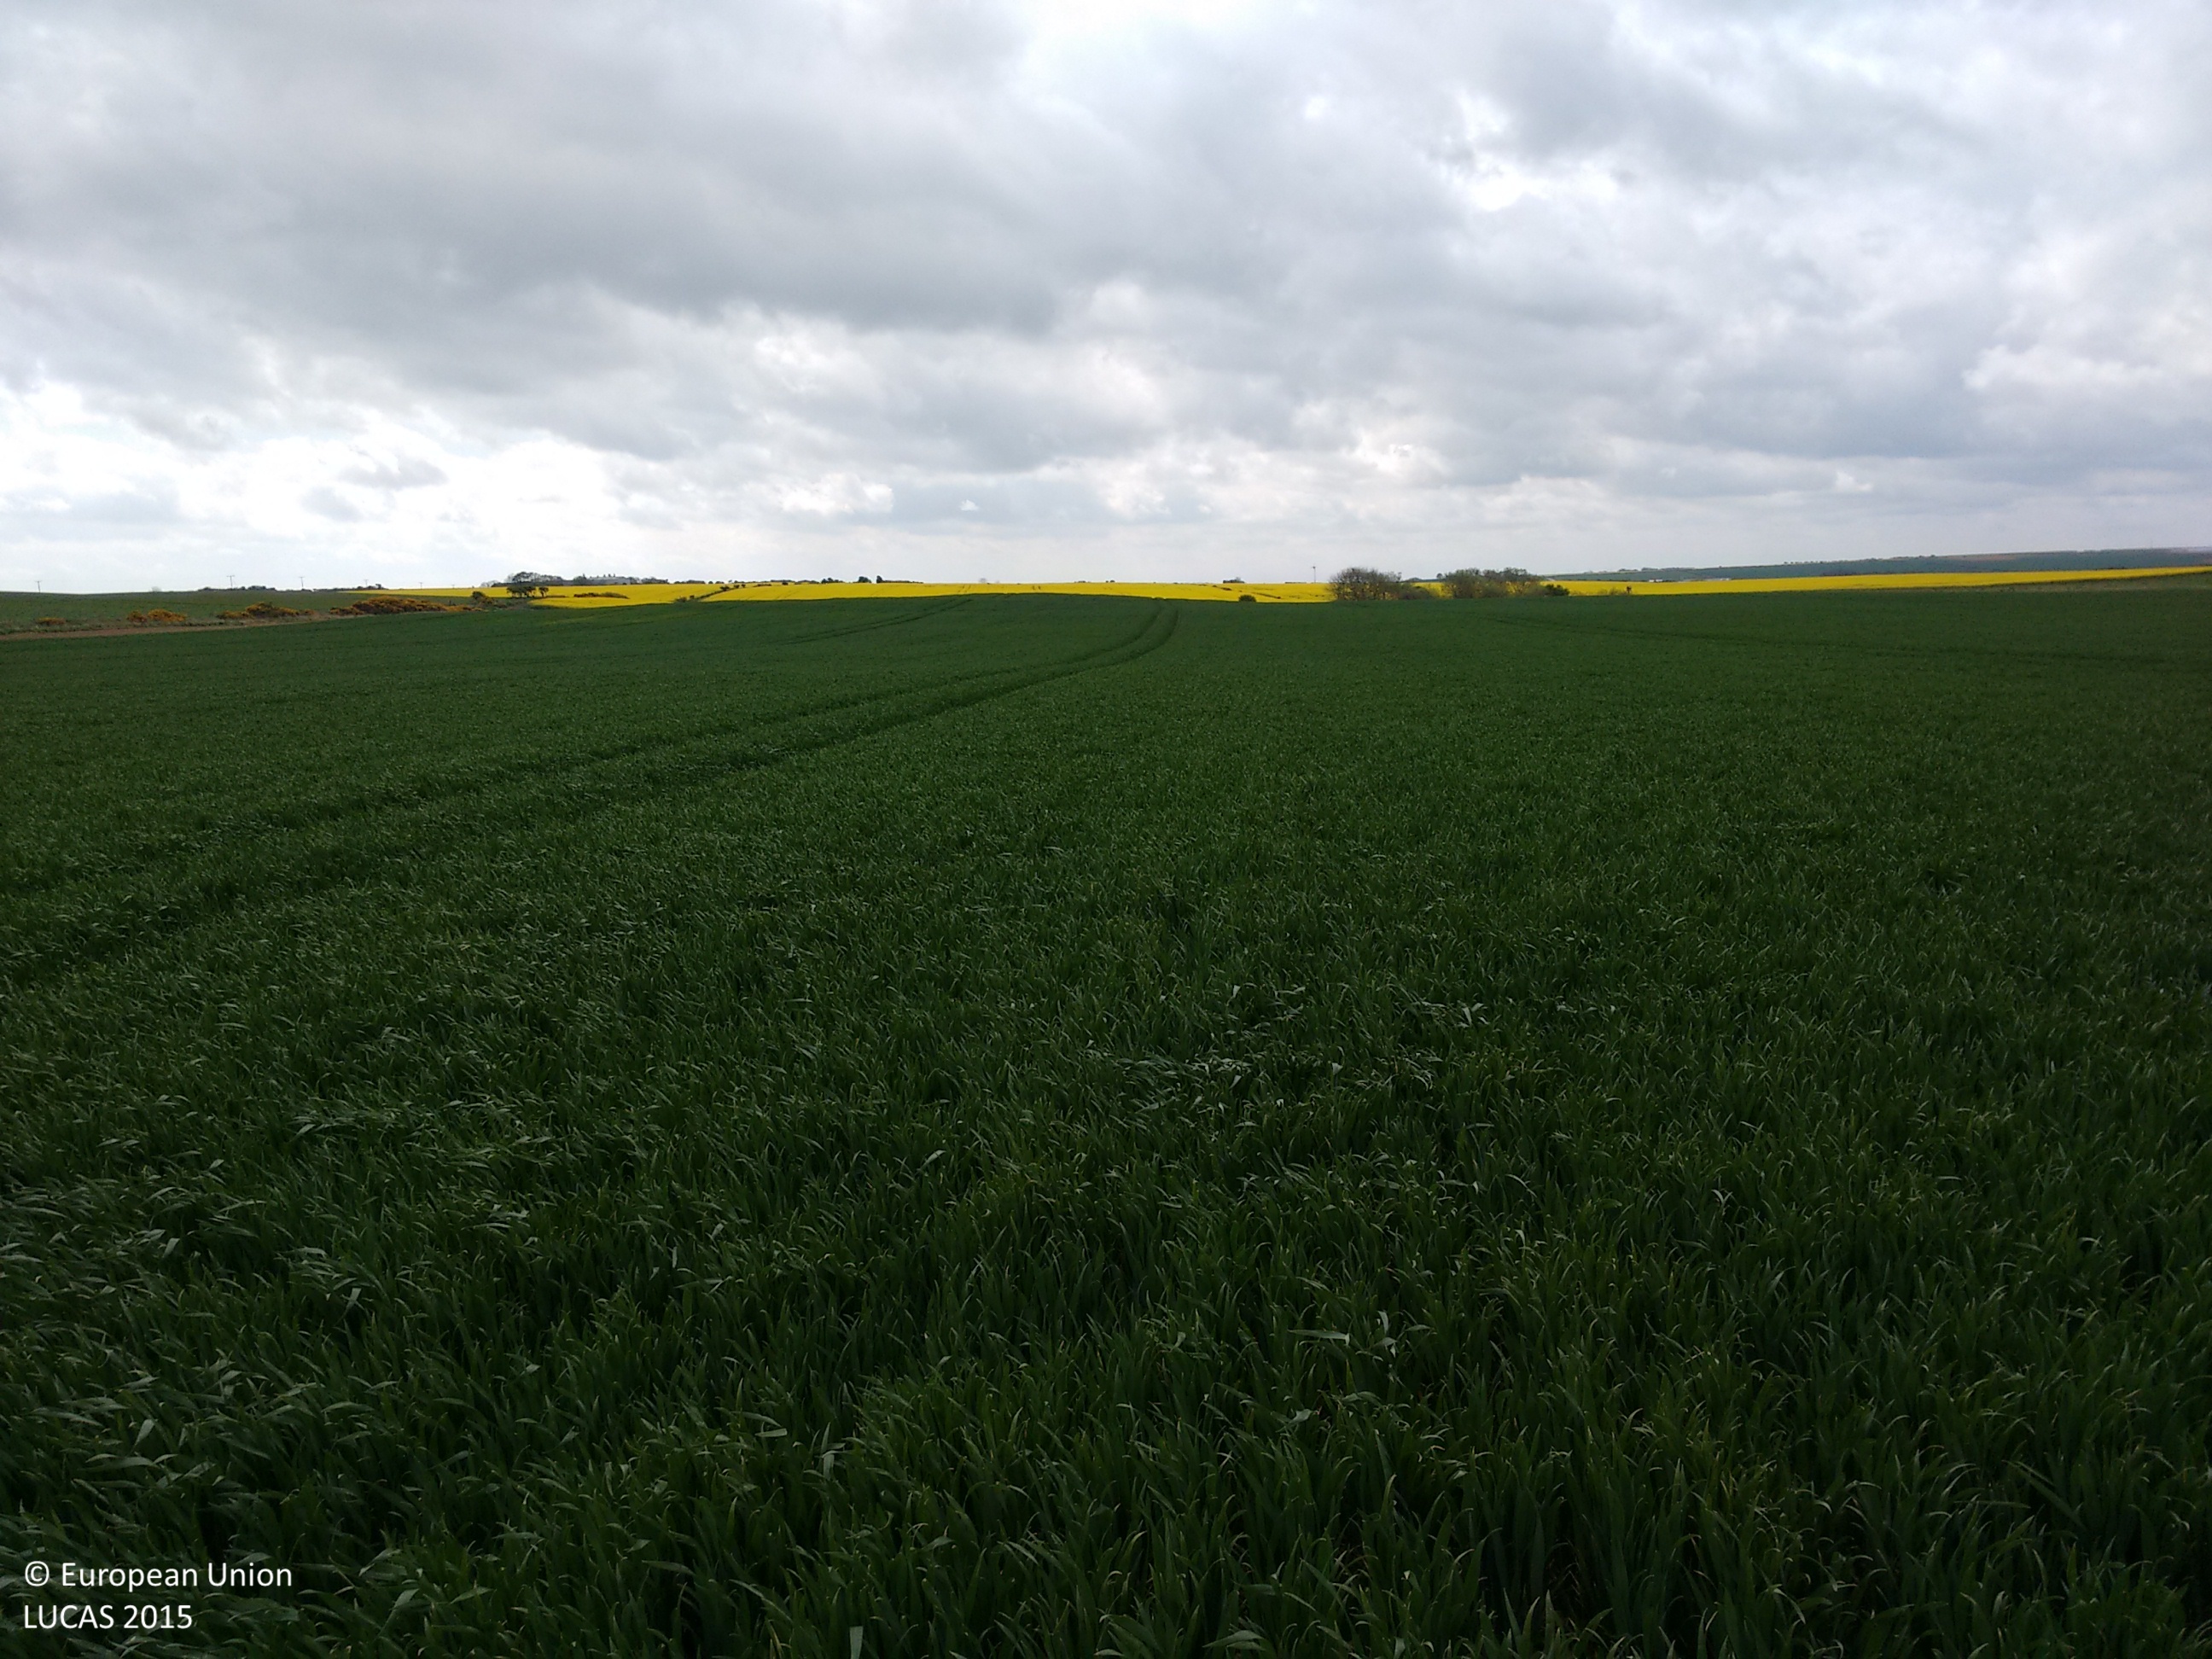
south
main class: Cropland
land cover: Common wheat
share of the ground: > 75 %
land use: Agriculture (excluding fallow land and kitchen gardens)
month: May
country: GB
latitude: 54.1498
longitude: -0.1837
